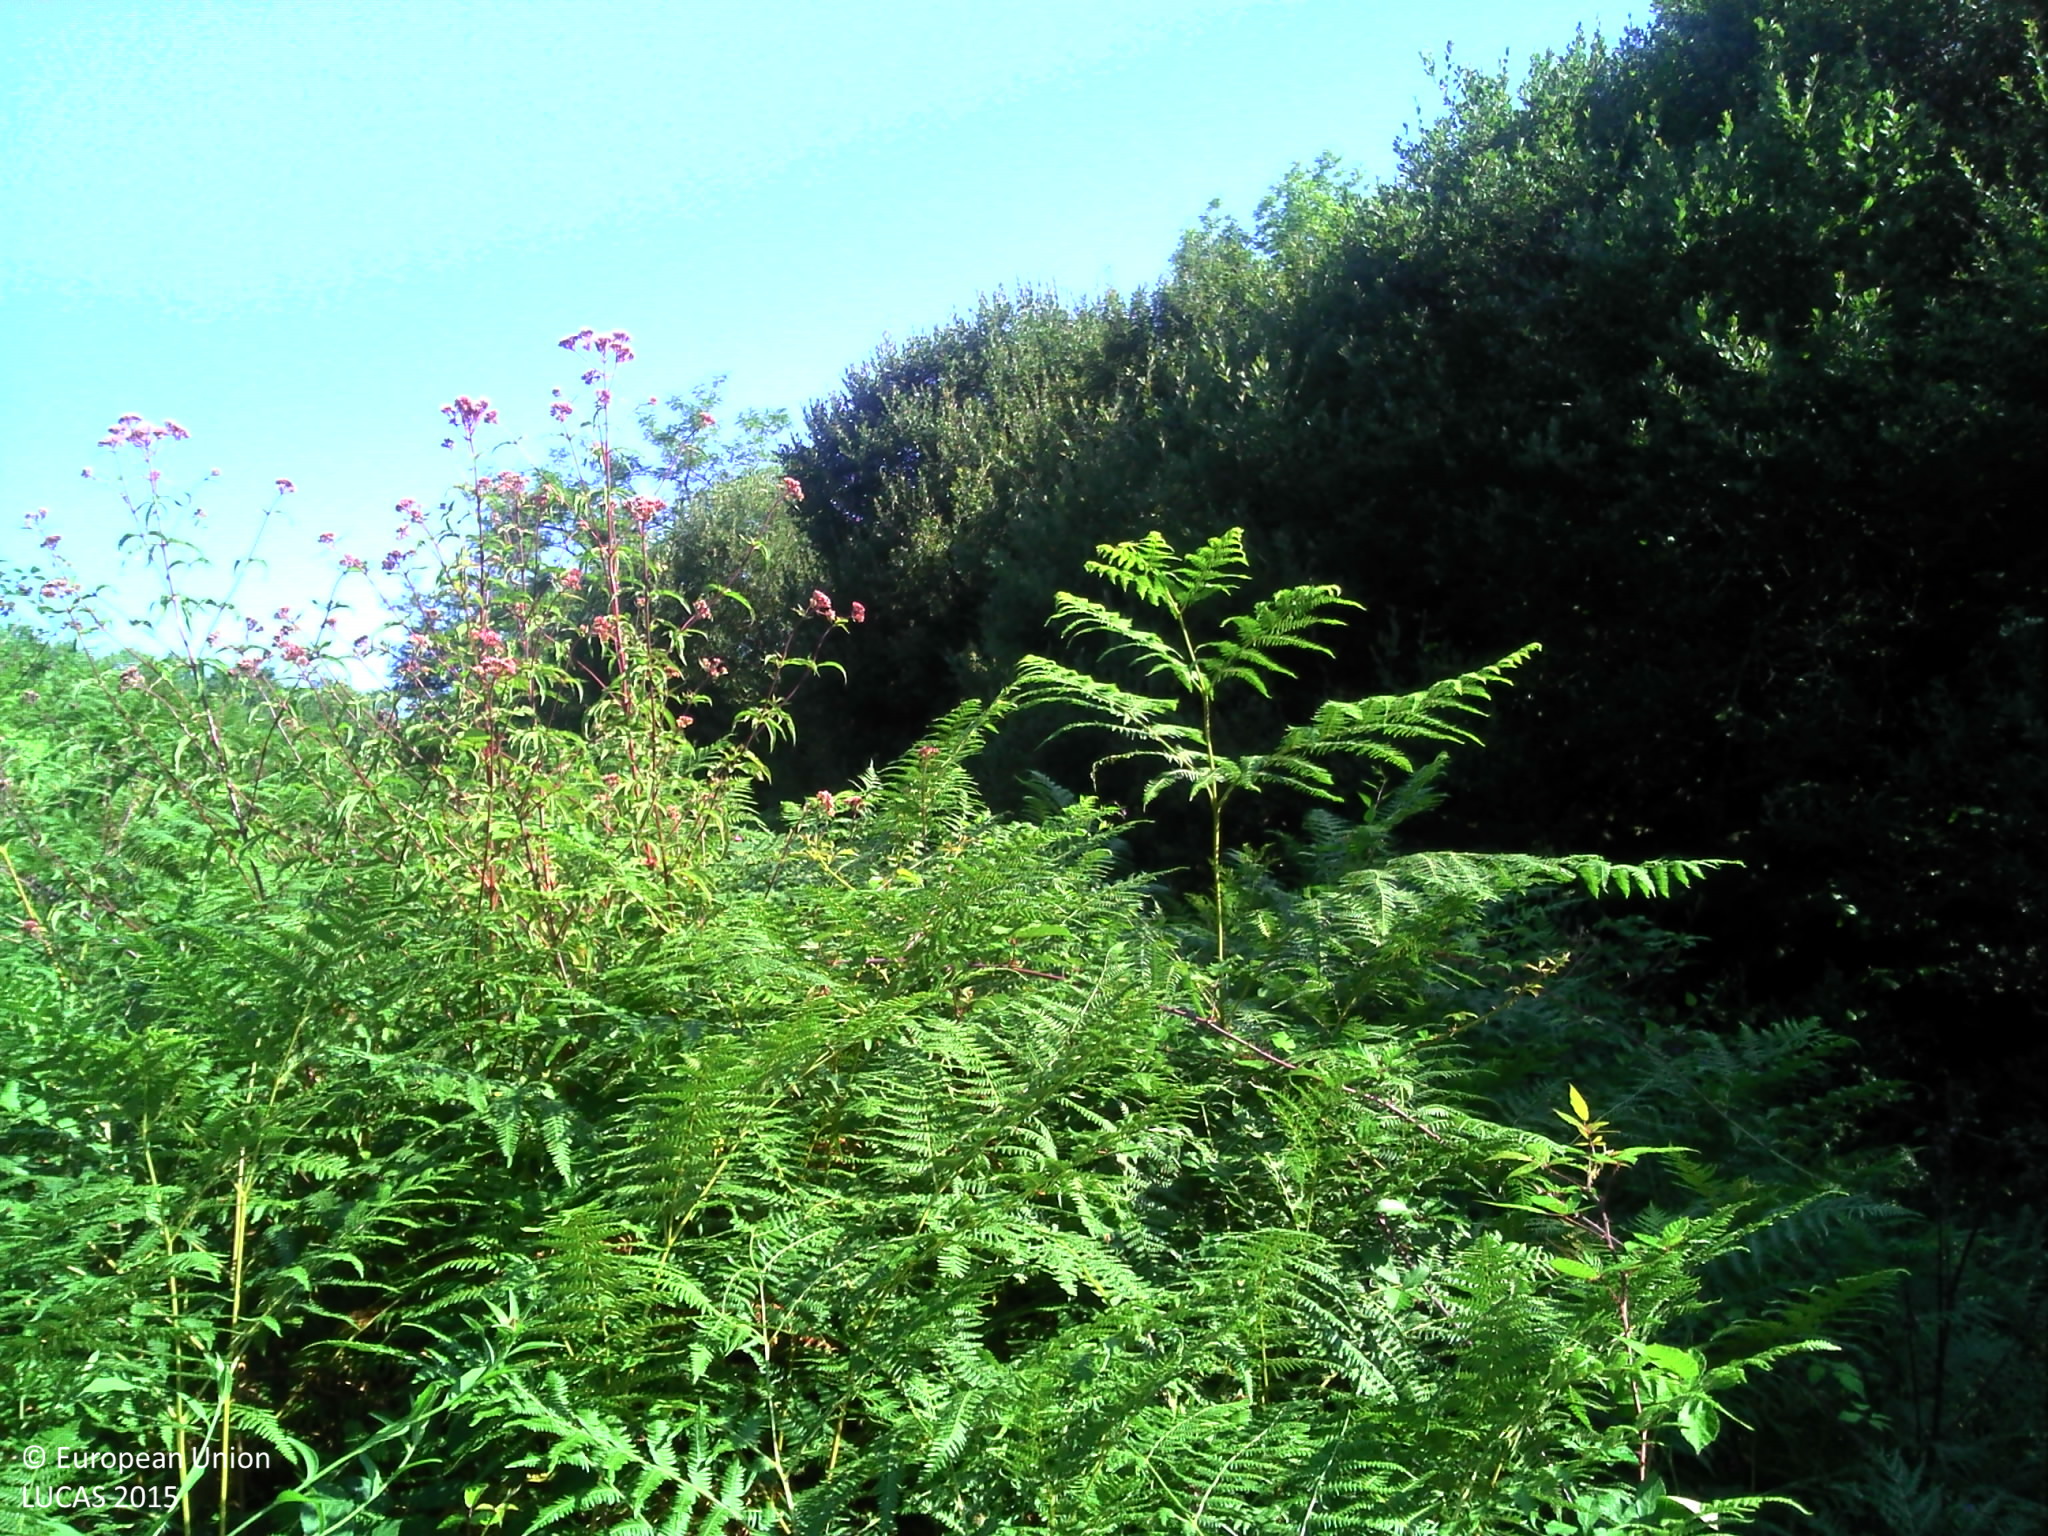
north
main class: Grassland
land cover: Spontaneously vegetated surfaces
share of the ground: > 75 %
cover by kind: herbaceous plants 95 %, shrubs 5 %
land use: Forestry
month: August
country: FR
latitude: 43.4717
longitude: -1.1778
